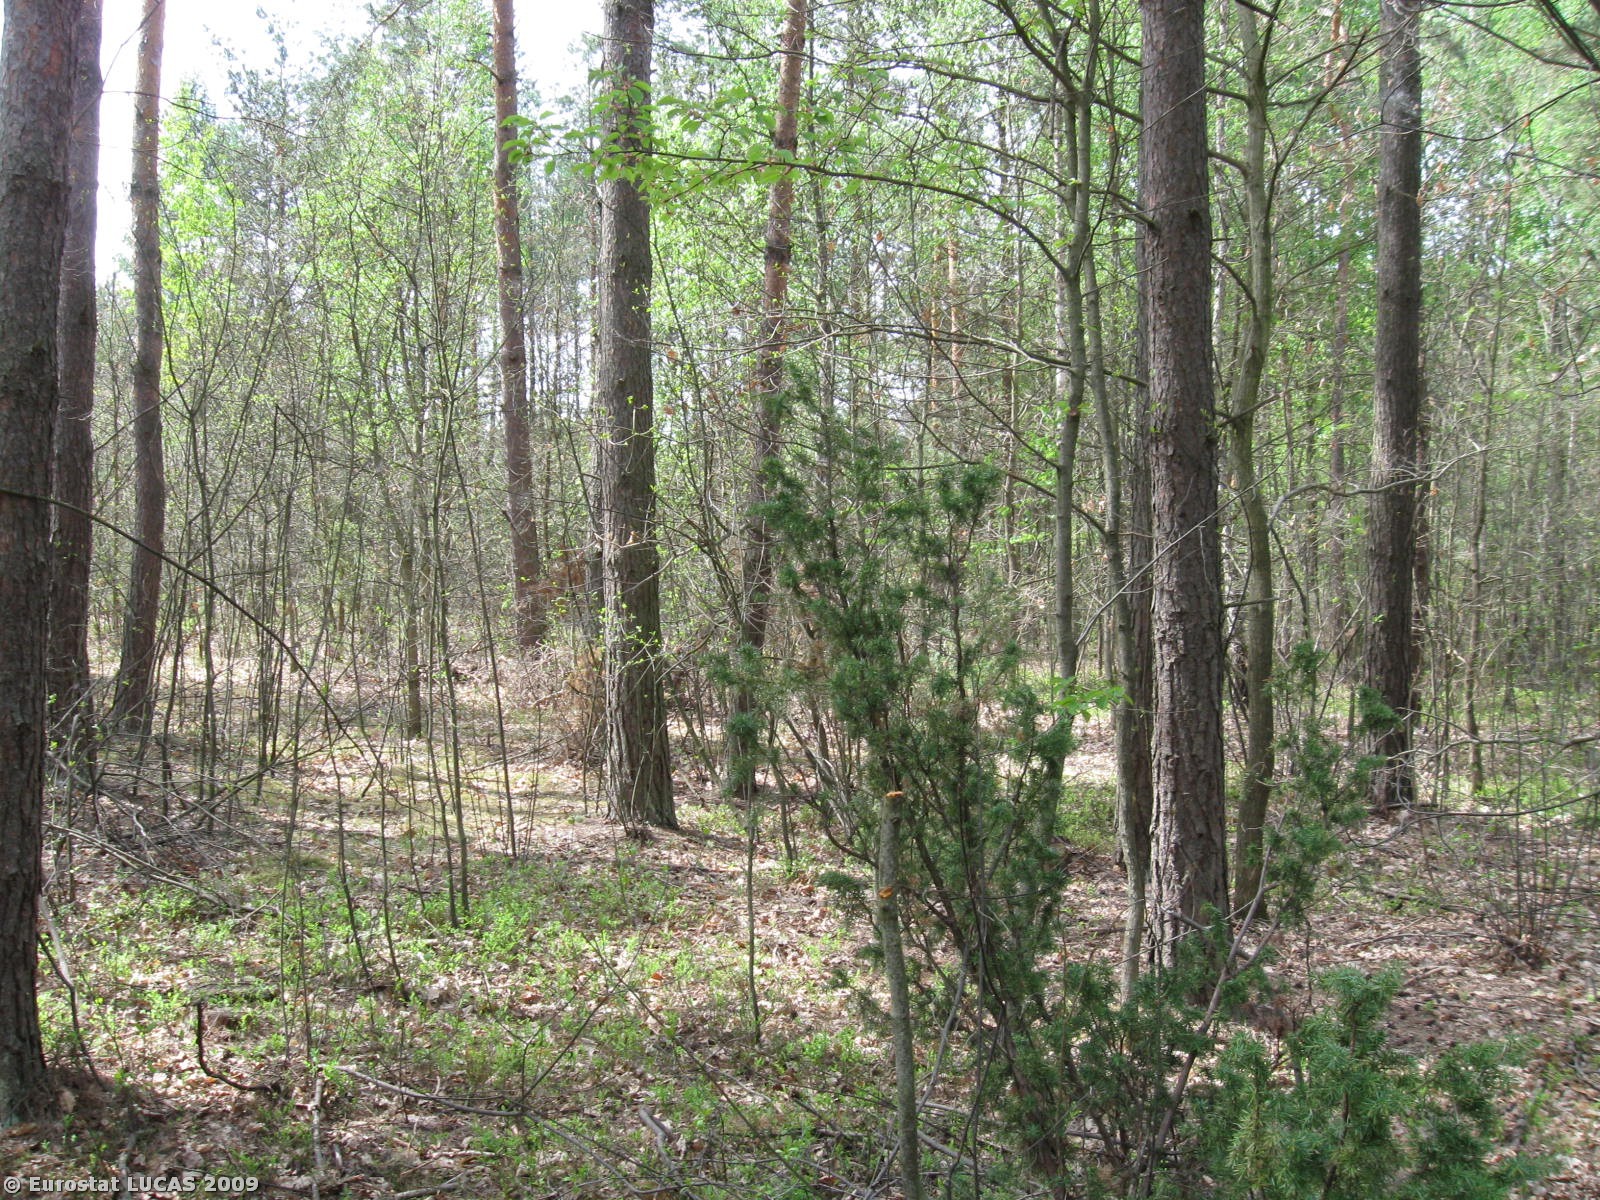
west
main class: Woodland
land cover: Mixed woodland
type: hemiboreal forest and nemoral coniferous forest and mixed broadleaved-coniferous forest
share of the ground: > 75 %
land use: Forestry
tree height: > 5 m
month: May
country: PL
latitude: 51.1651
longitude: 20.5210
